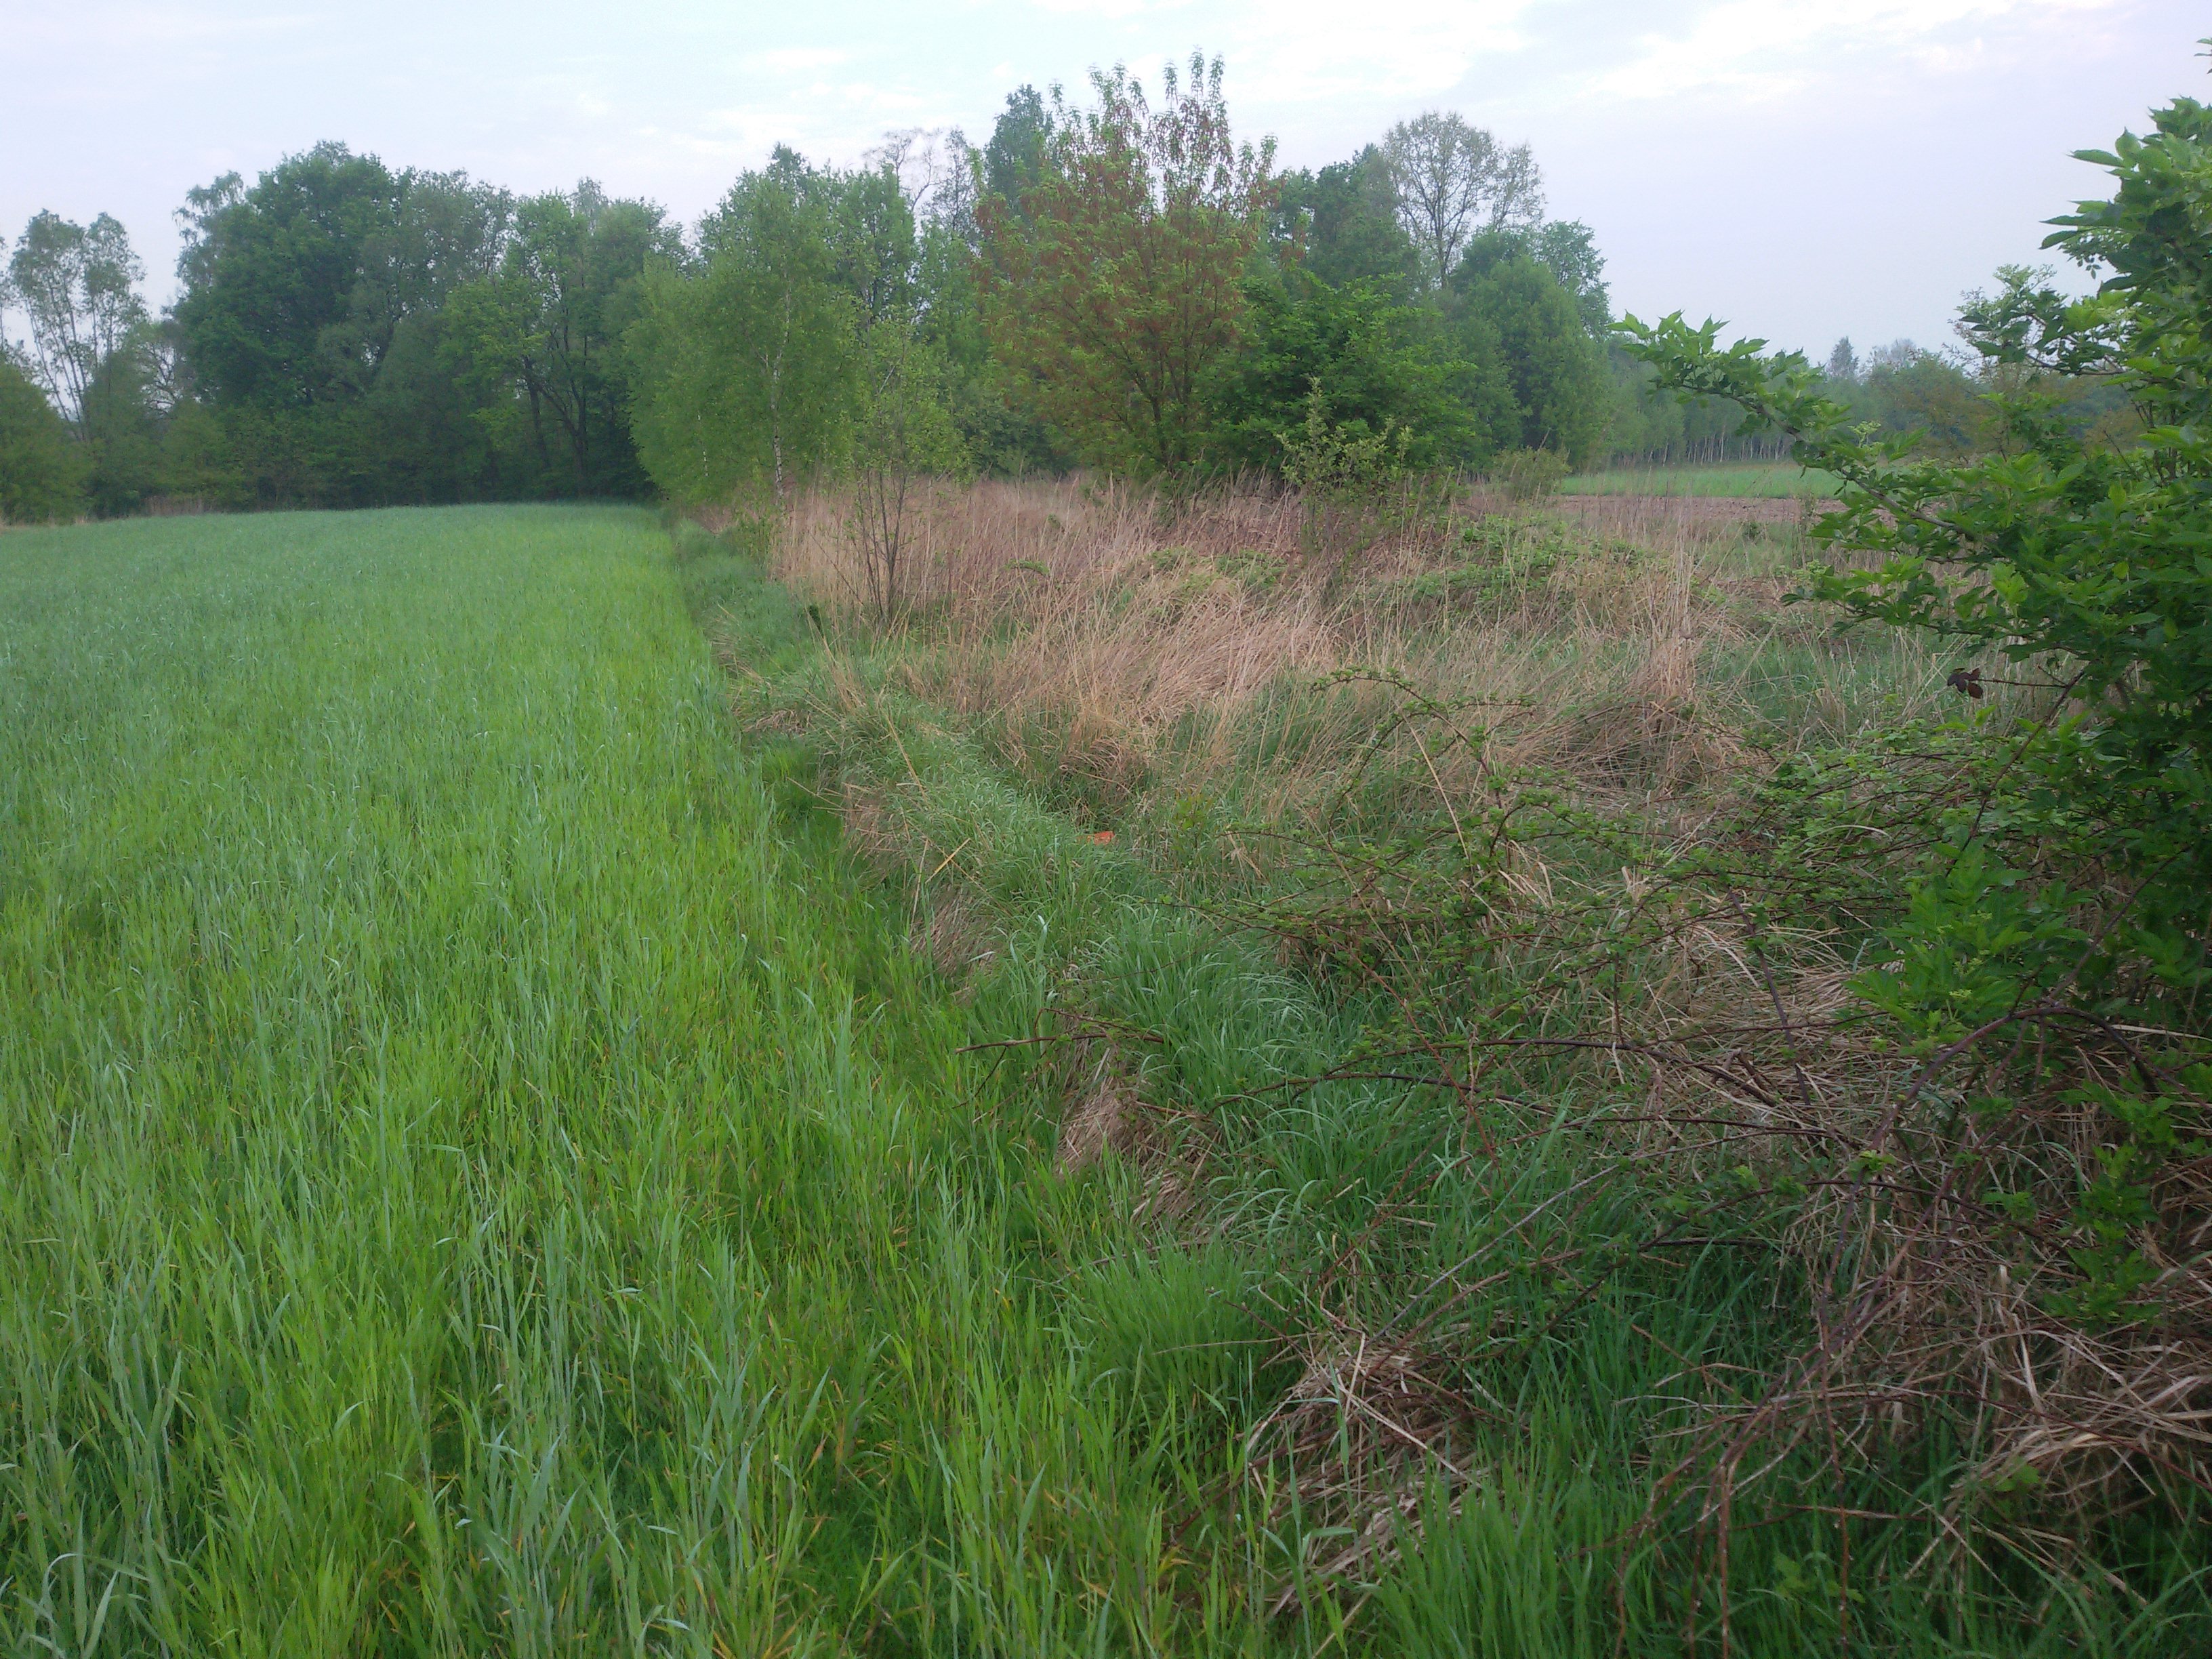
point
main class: Grassland
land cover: Spontaneously vegetated surfaces
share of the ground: > 75 %
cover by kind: herbaceous plants 95 %, shrubs 5 %
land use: Semi-natural and natural areas not in use
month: May
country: PL
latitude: 50.4780
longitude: 21.6217
